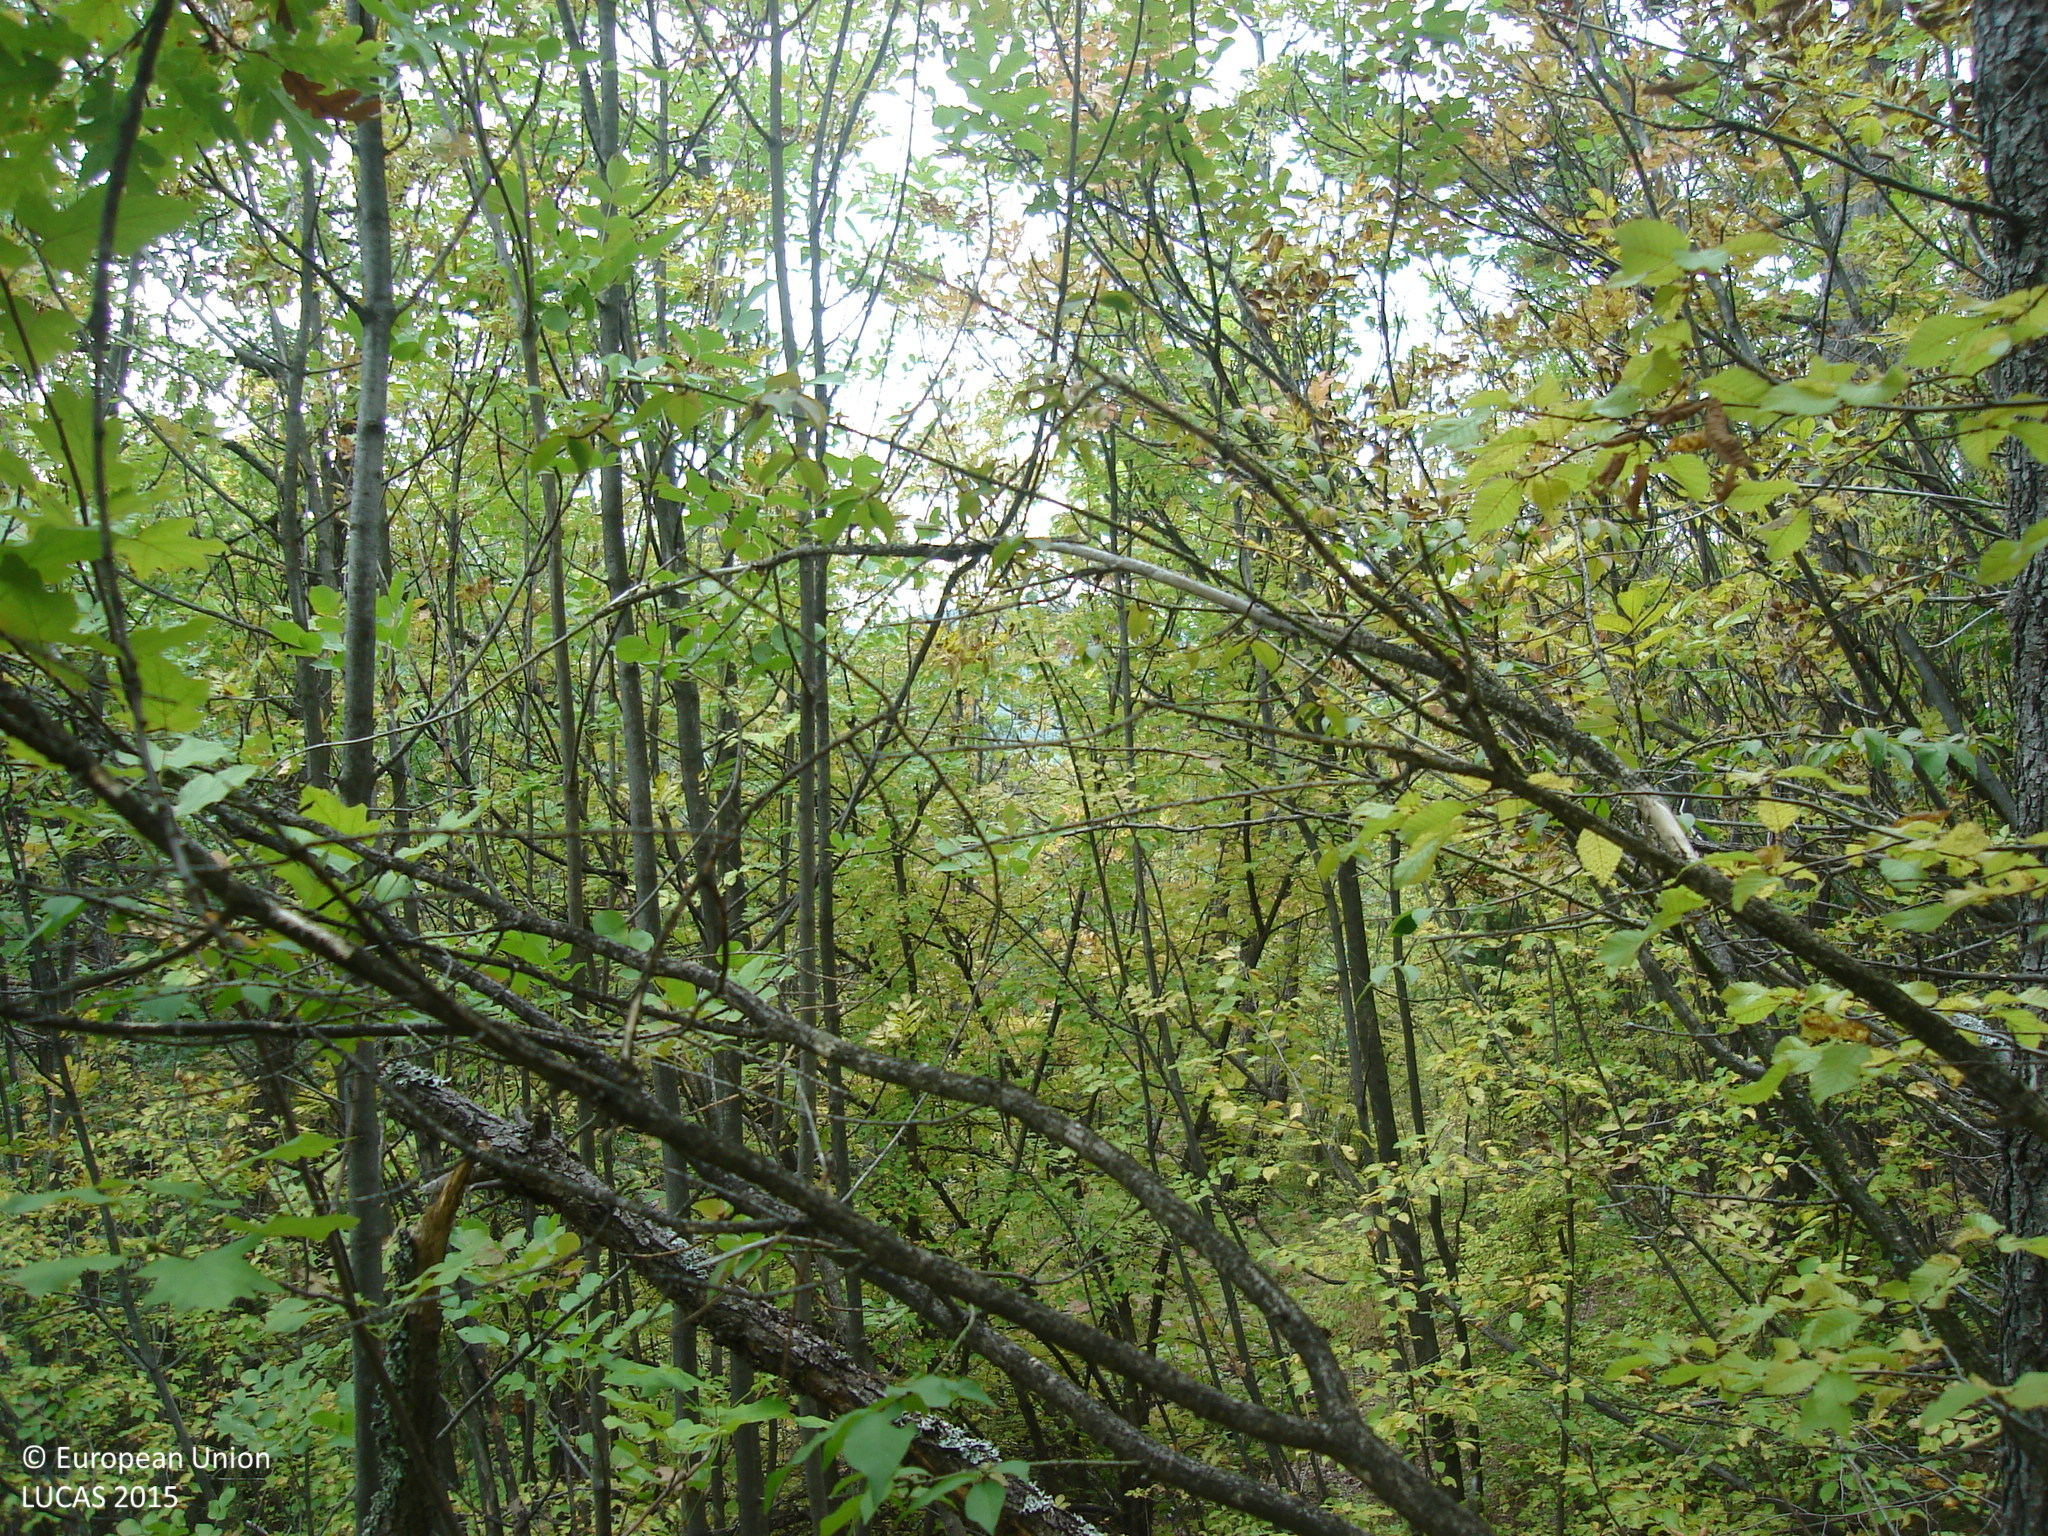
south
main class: Woodland
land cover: Broadleaved woodland
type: mesophytic deciduous forest
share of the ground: > 75 %
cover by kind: broadleaved forest trees 80 %, shrubs 10 %, herbaceous plants 5 %, unconsolidated bare surface 5 %
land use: Forestry
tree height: > 5 m
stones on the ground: < 10 %
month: October
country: BG
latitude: 42.6127
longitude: 23.9771
